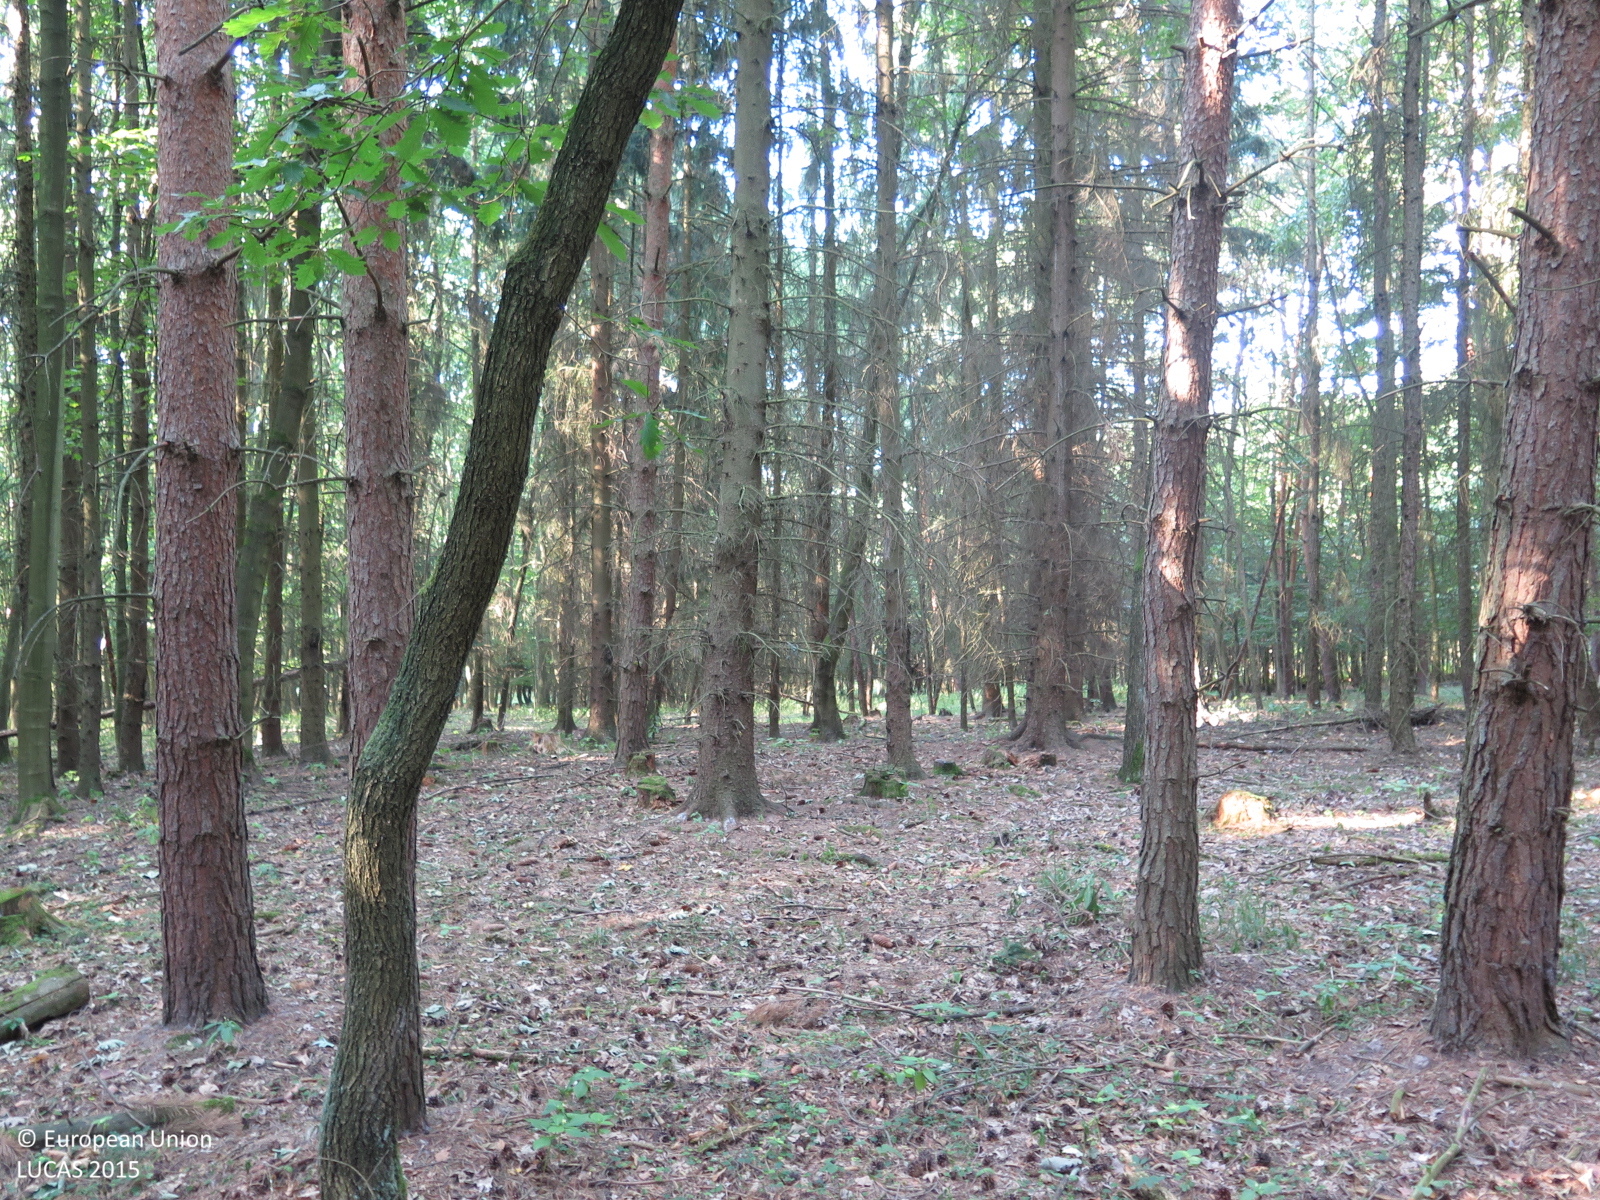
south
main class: Woodland
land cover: Other coniferous woodland
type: hemiboreal forest and nemoral coniferous forest and mixed broadleaved-coniferous forest
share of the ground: > 75 %
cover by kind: coniferous forest trees 90 %, broadleaved forest trees 5 %, herbaceous plants 5 %
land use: Forestry
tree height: > 5 m
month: August
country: CZ
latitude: 50.0835
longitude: 13.8439
